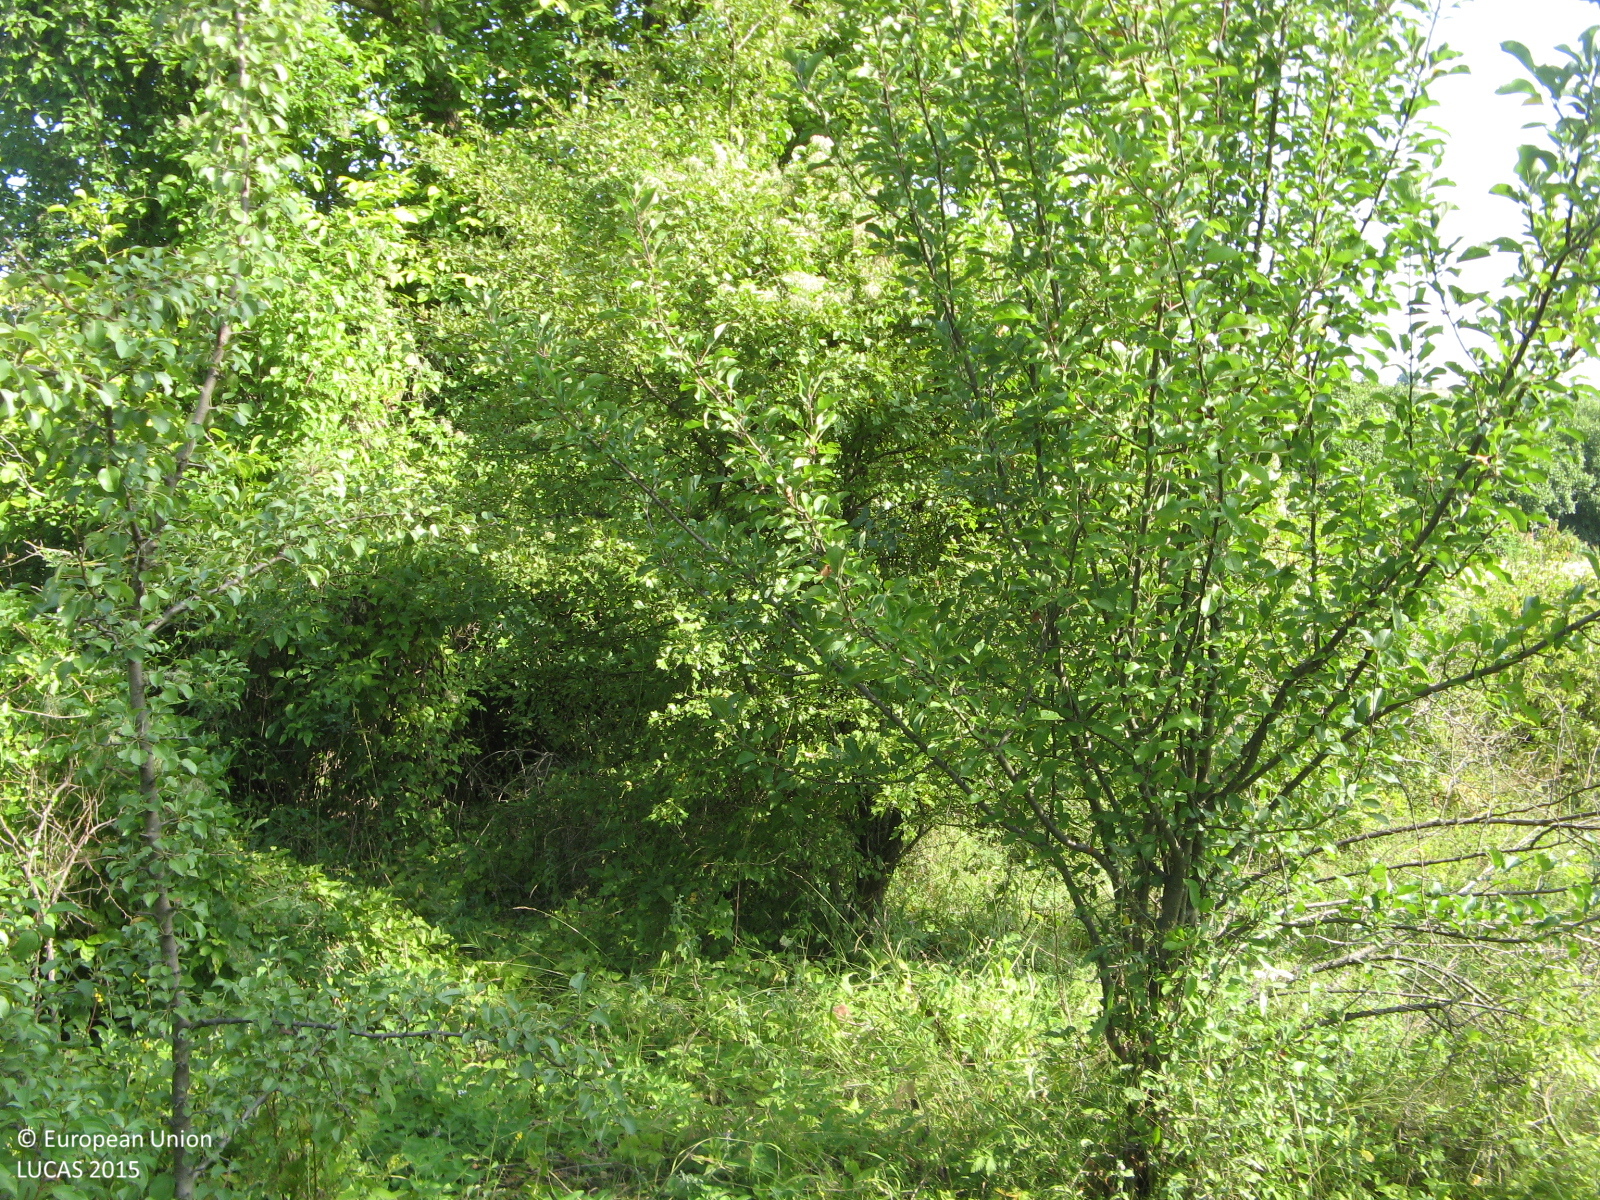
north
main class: Woodland
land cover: Broadleaved woodland
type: thermophilous deciduous forest
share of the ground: > 75 %
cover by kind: broadleaved forest trees 85 %, shrubs 10 %, herbaceous plants 5 %
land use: Forestry
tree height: > 5 m
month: August
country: BG
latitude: 43.5678
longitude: 25.3452
